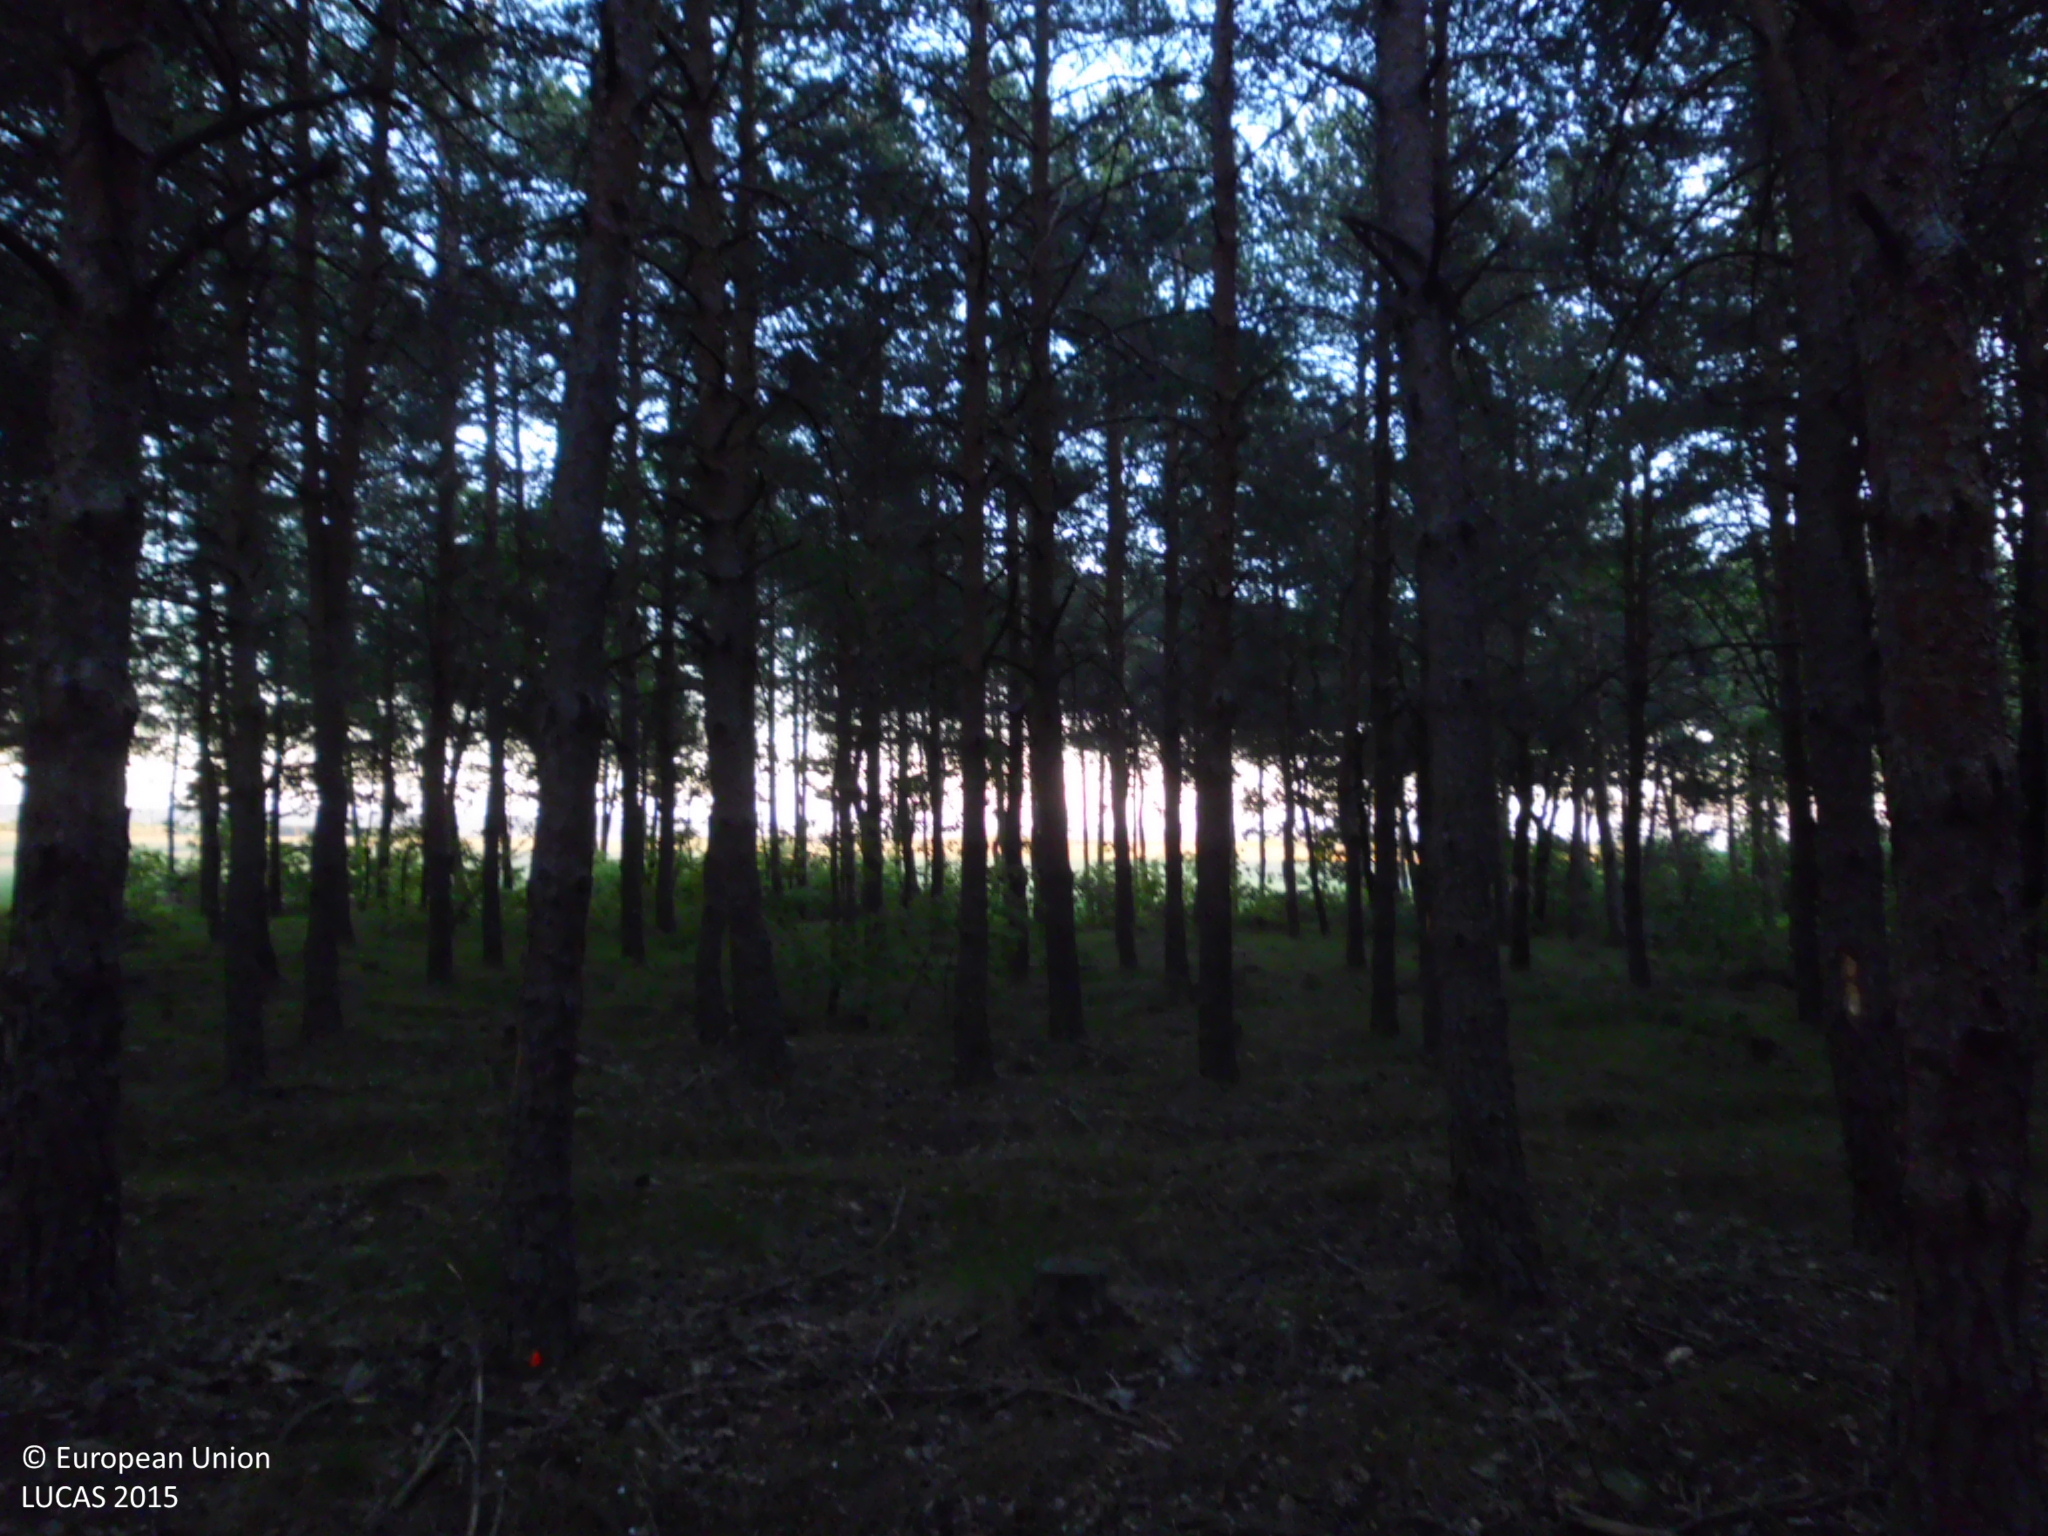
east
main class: Woodland
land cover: Pine dominated coniferous woodland
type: coniferous forest of the mediterranean region
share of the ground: > 75 %
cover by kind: coniferous forest trees 100 %
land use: Forestry
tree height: > 5 m
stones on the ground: > 50 %
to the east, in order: Pine dominated coniferous woodland; Tracks; Rye; Common wheat
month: May
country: ES
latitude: 42.5983
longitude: -4.8420
